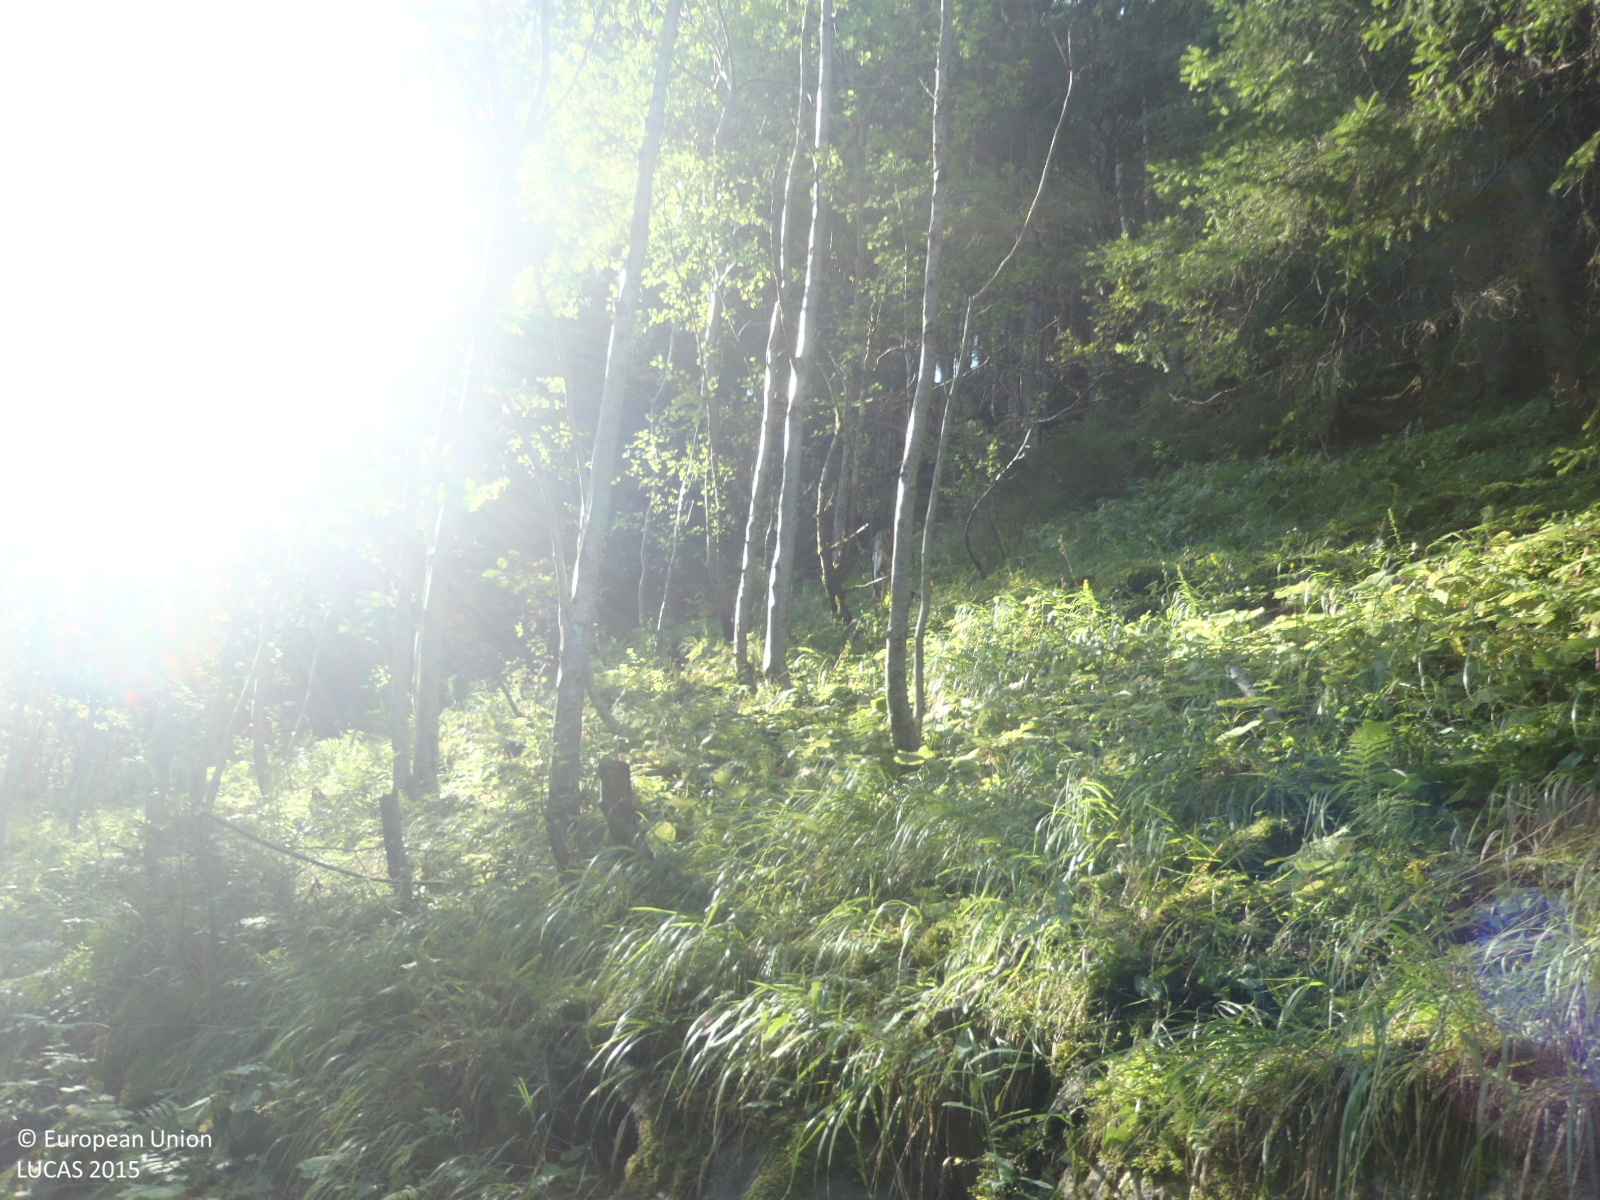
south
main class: Woodland
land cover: Spruce dominated coniferous woodland
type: alpine coniferous forest
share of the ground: > 75 %
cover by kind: coniferous forest trees 100 %
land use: Forestry
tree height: > 5 m
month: August
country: AT
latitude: 46.8953
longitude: 12.6359
